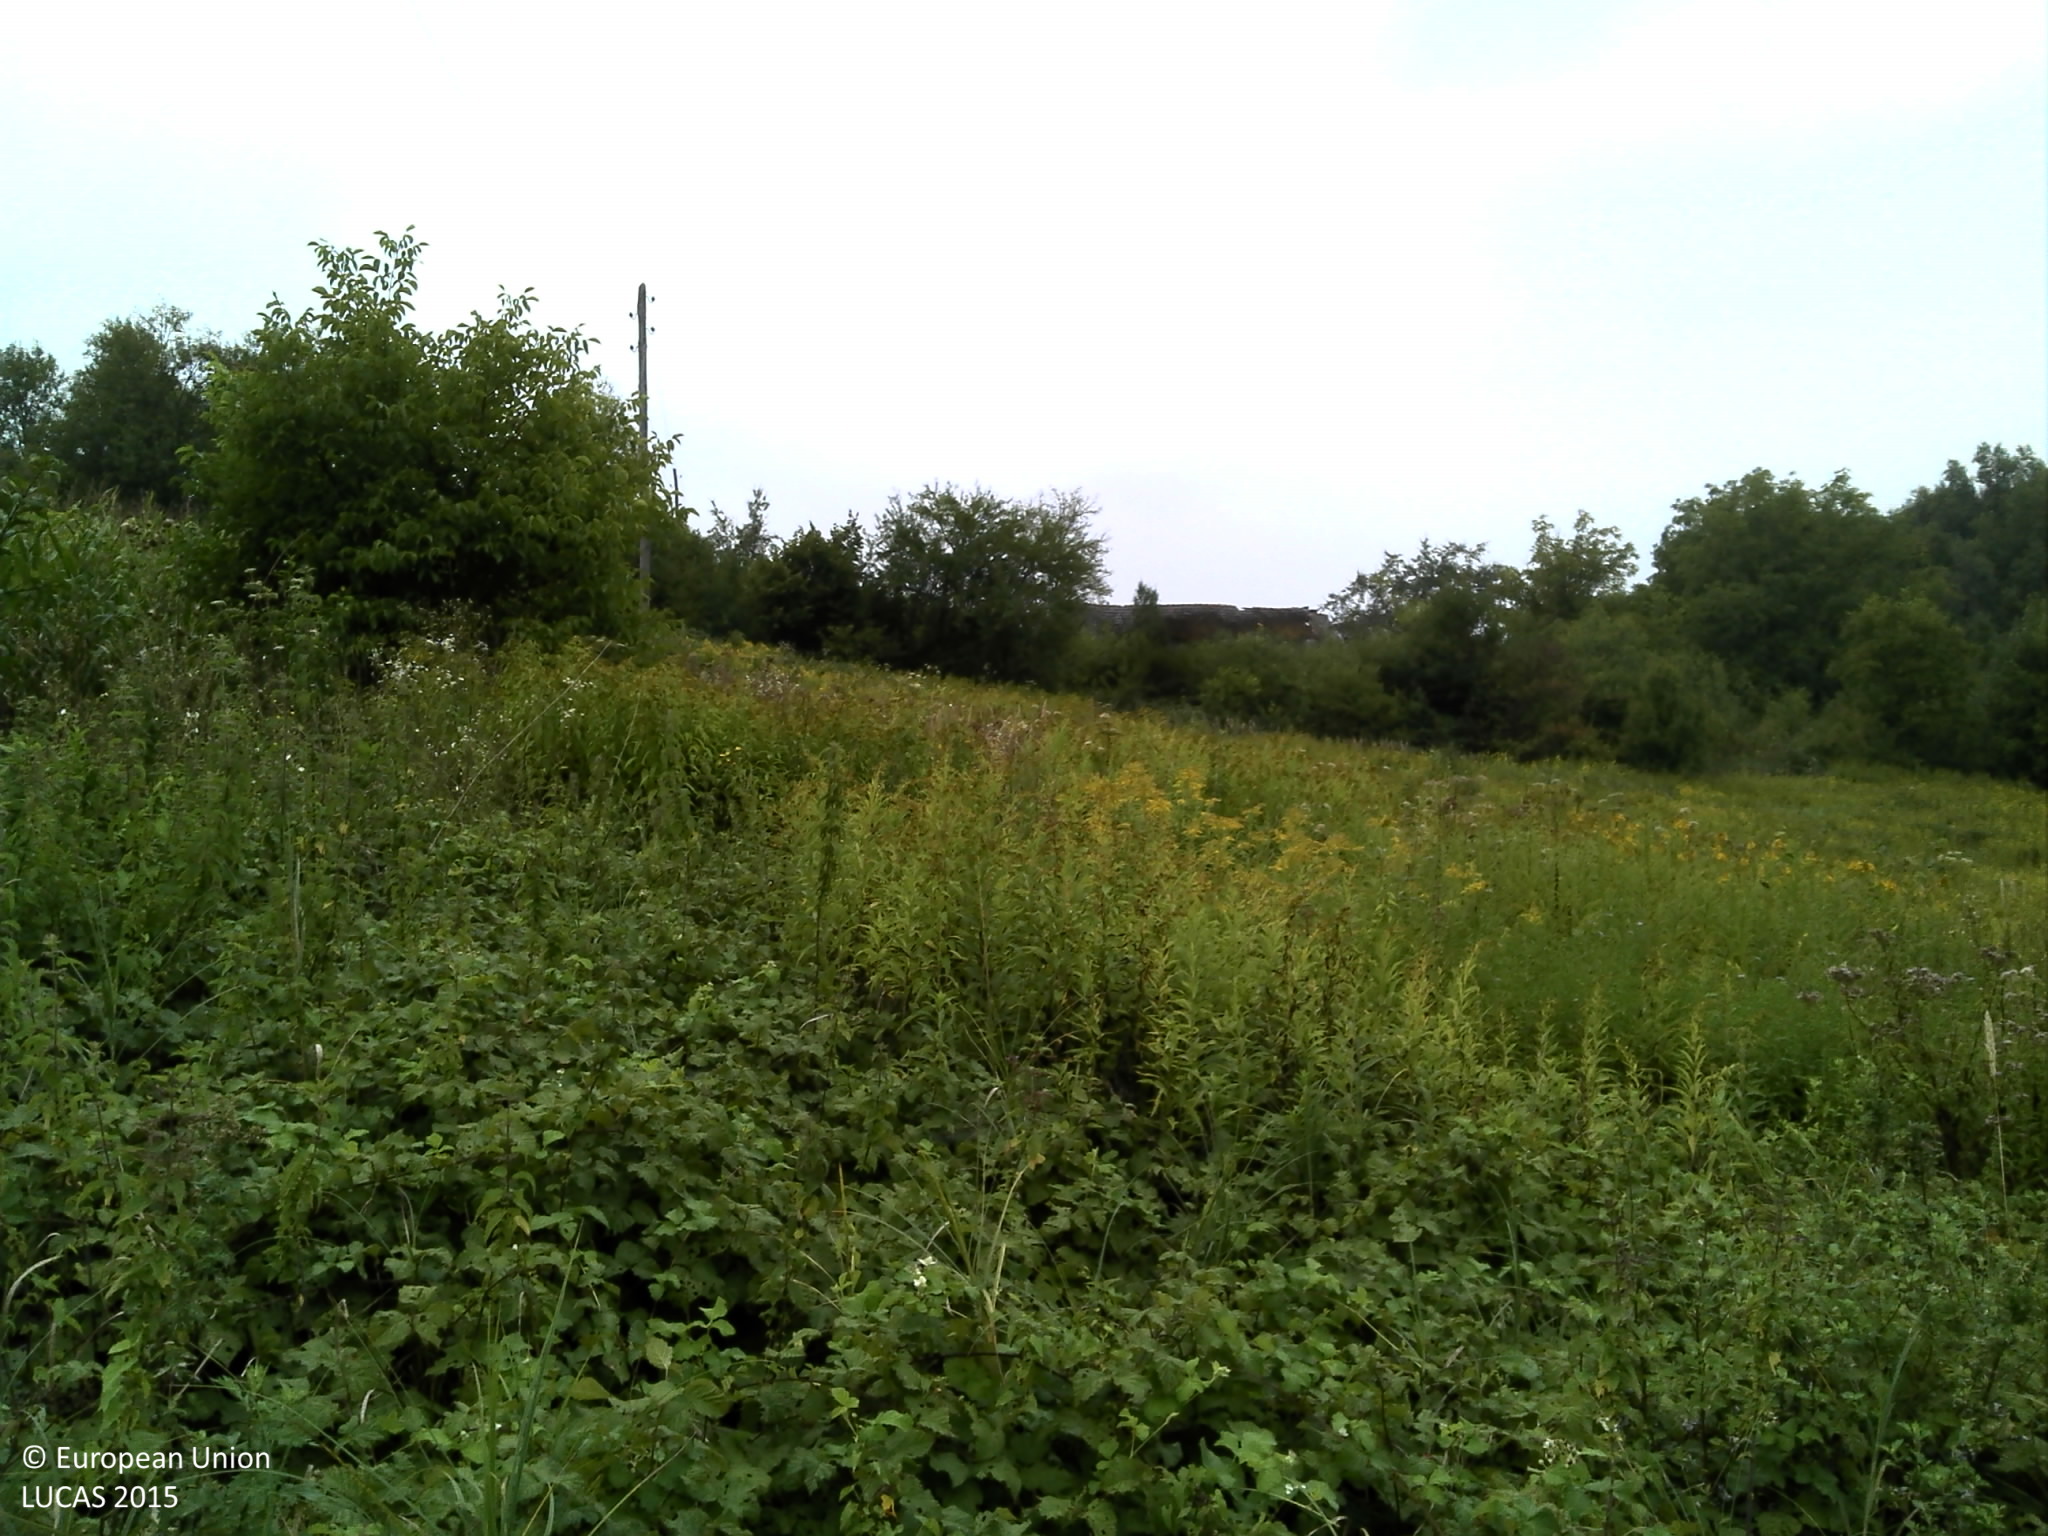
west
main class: Grassland
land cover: Spontaneously vegetated surfaces
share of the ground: > 75 %
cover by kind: herbaceous plants 100 %
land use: Semi-natural and natural areas not in use
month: August
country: HR
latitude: 45.2978
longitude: 15.6706
